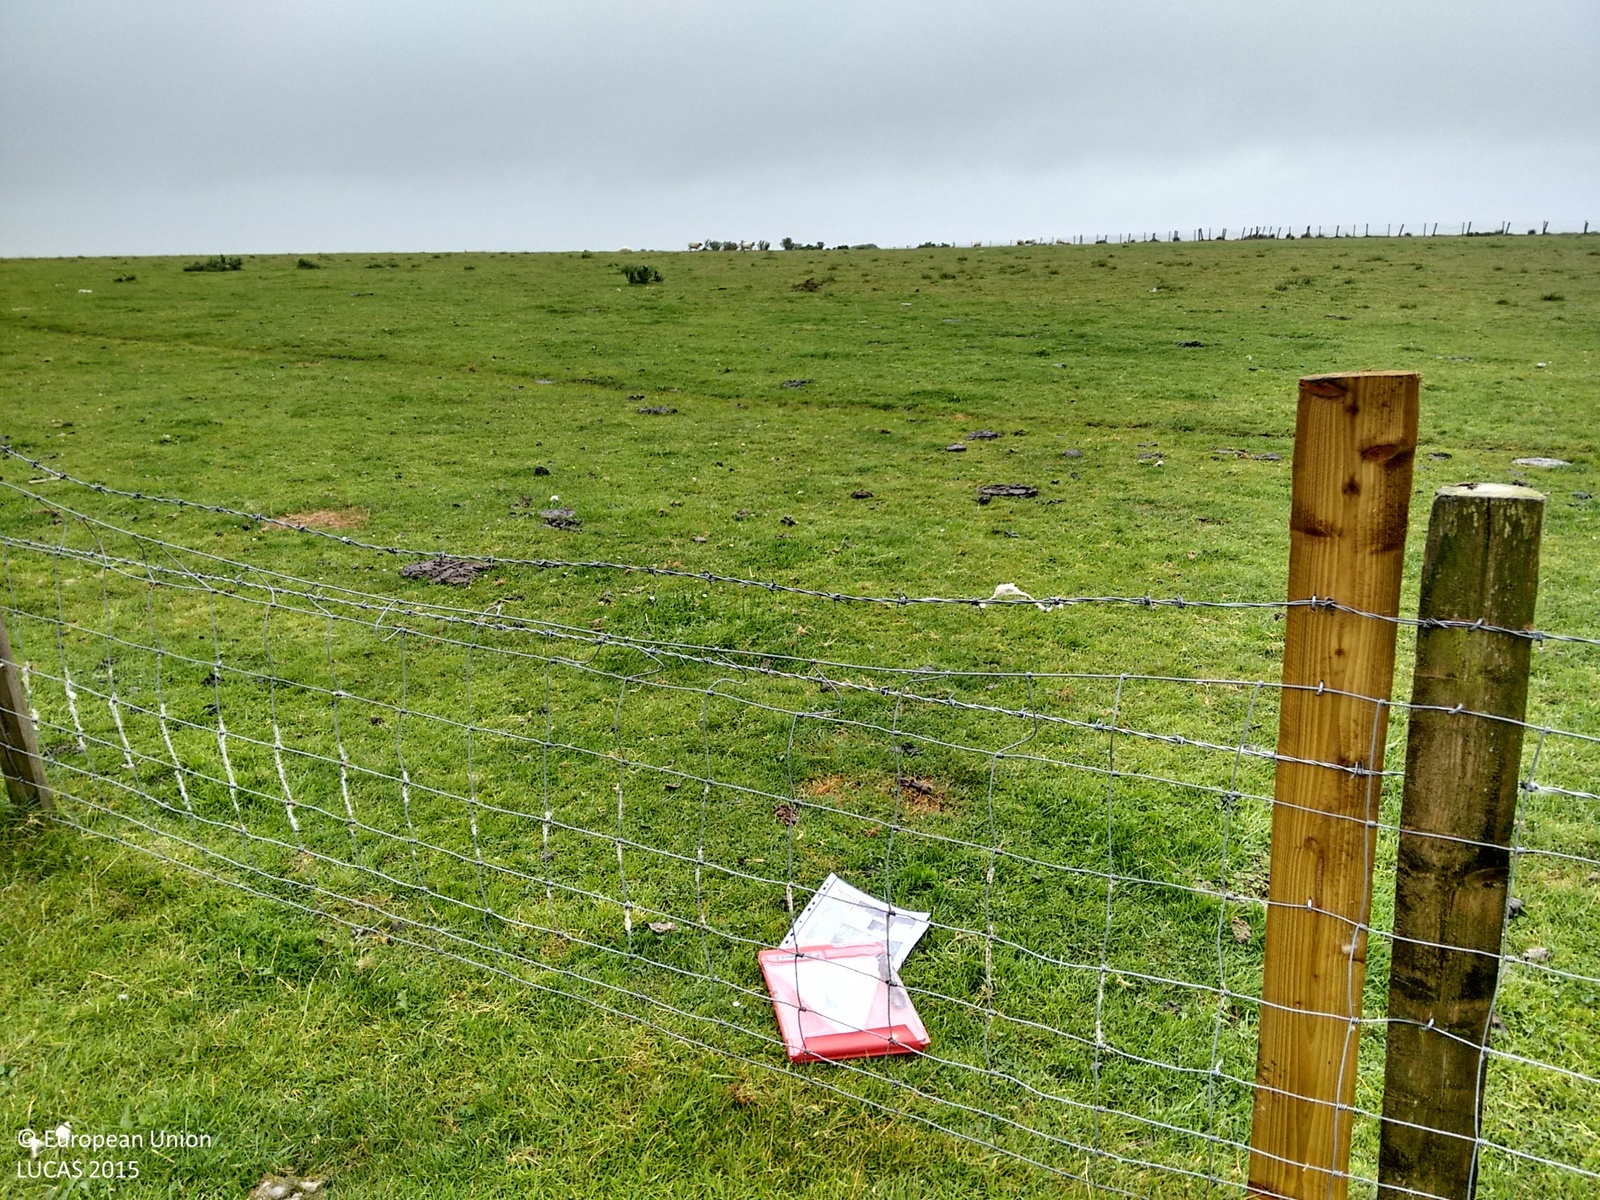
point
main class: Grassland
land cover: Grassland without tree/shrub cover
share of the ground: > 75 %
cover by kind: herbaceous plants 100 %
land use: Agriculture (excluding fallow land and kitchen gardens)
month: August
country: GB
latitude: 51.9528
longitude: -4.5256
